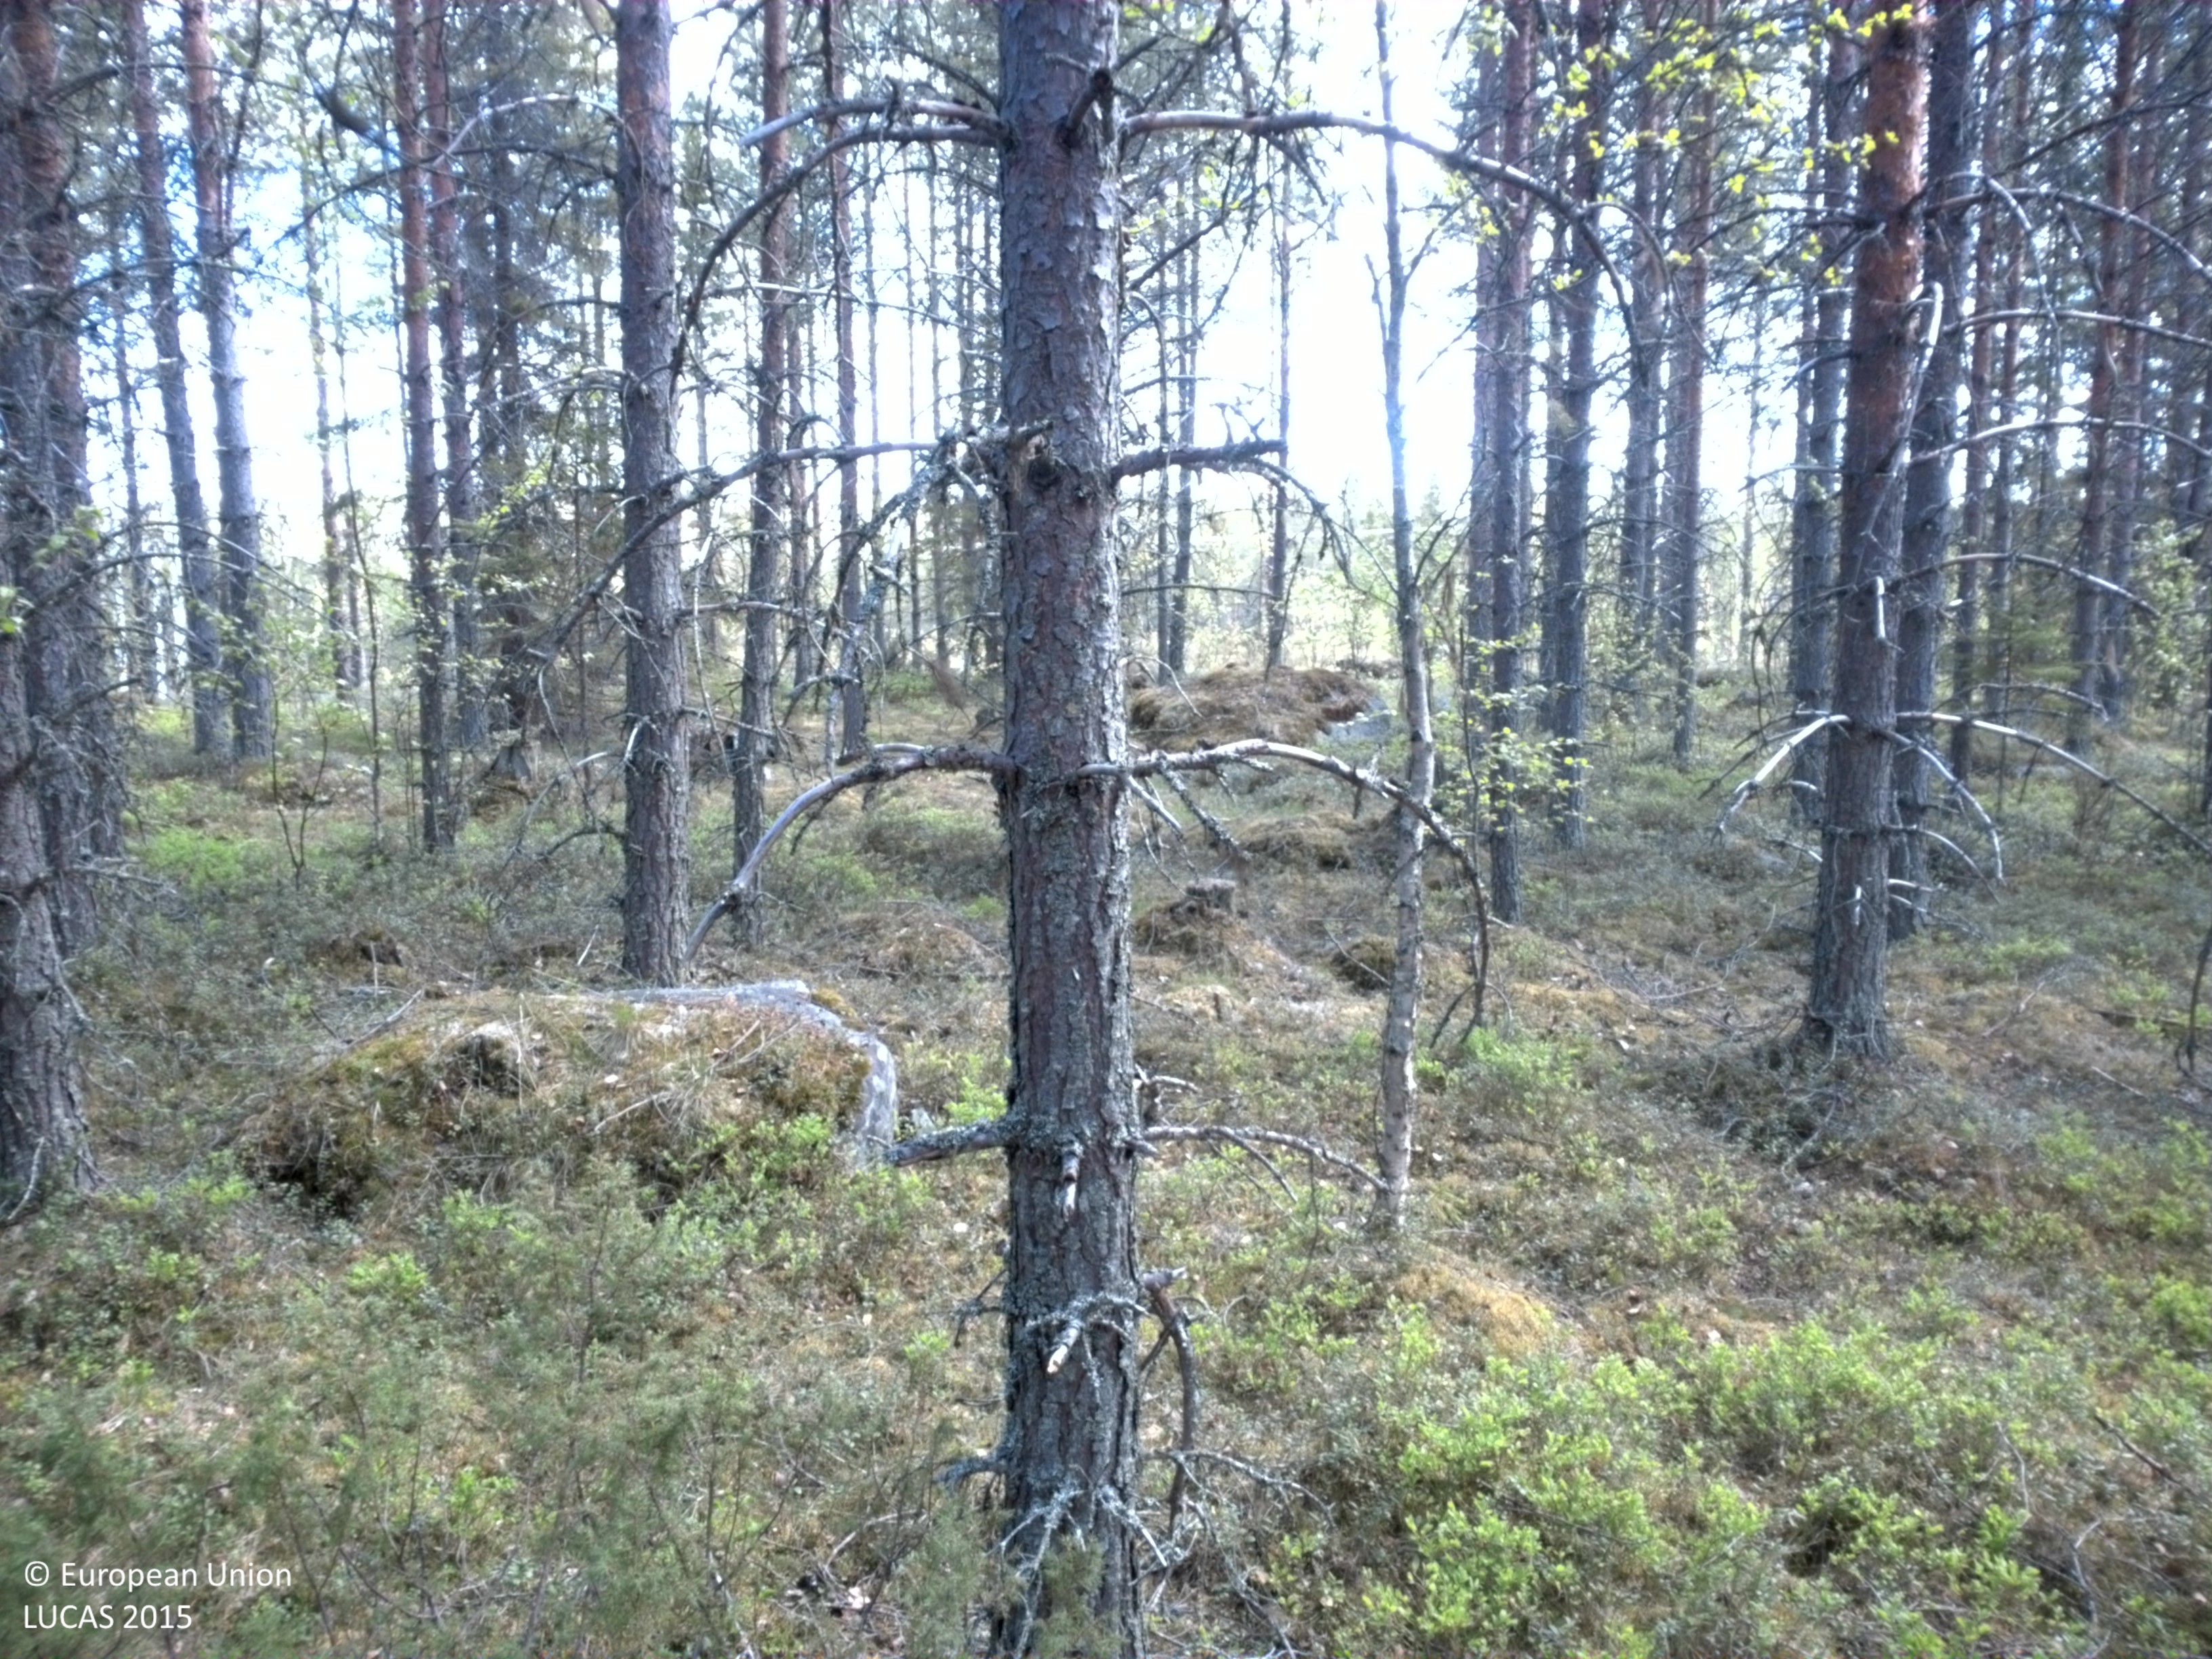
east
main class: Woodland
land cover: Pine dominated coniferous woodland
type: boreal forest
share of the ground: 50 - 75 %
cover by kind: coniferous forest trees 45 %, lichens and mosses 25 %, herbaceous plants 15 %, broadleaved forest trees 10 %, shrubs 5 %
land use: Forestry
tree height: > 5 m
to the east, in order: Pine dominated coniferous woodland; Shrubland without tree cover; Electric lines; Shrubland without tree cover; Pine dominated coniferous woodland; Ditches and canals; Paved roads, cycling and walking lanes; Ditches and canals; Pine dominated coniferous woodland; Ditches and canals; Pine dominated coniferous woodland
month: June
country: SE
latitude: 64.2505
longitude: 17.2515
